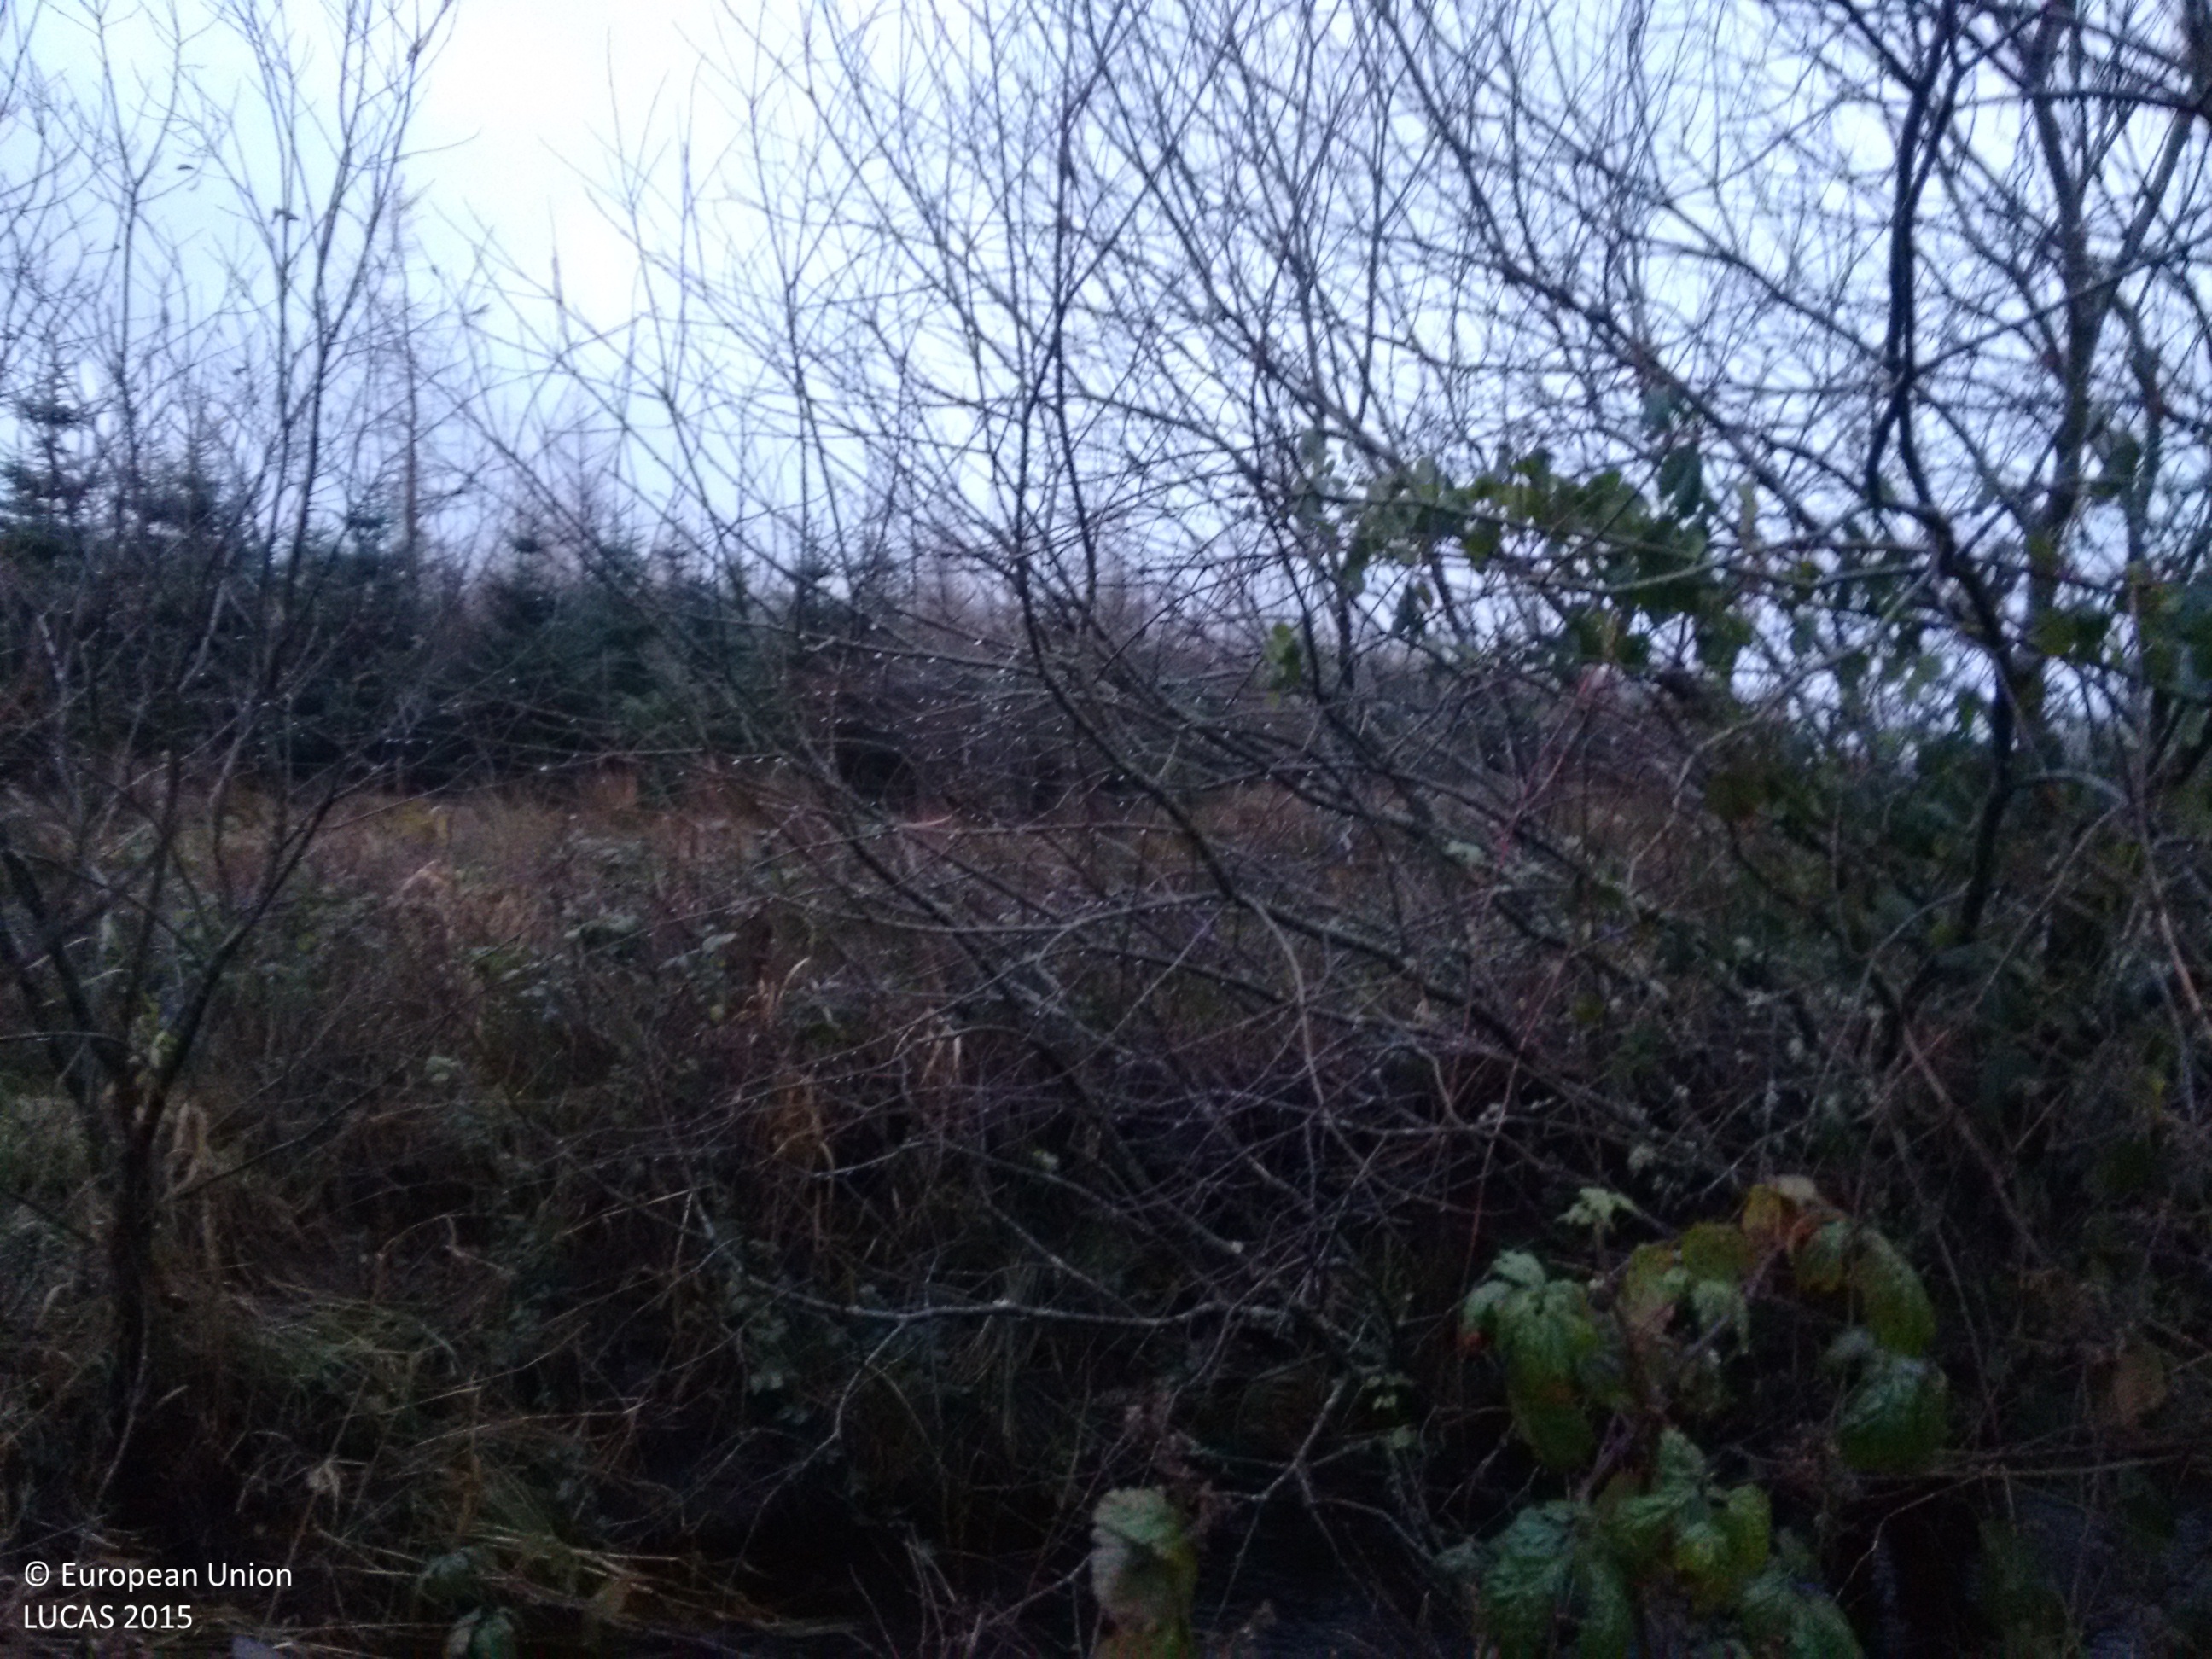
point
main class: Woodland
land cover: Spruce dominated coniferous woodland
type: exotic forest
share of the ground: > 75 %
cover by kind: coniferous forest trees 100 %
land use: Forestry
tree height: > 5 m
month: December
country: IE
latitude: 54.2223
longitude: -7.9480
